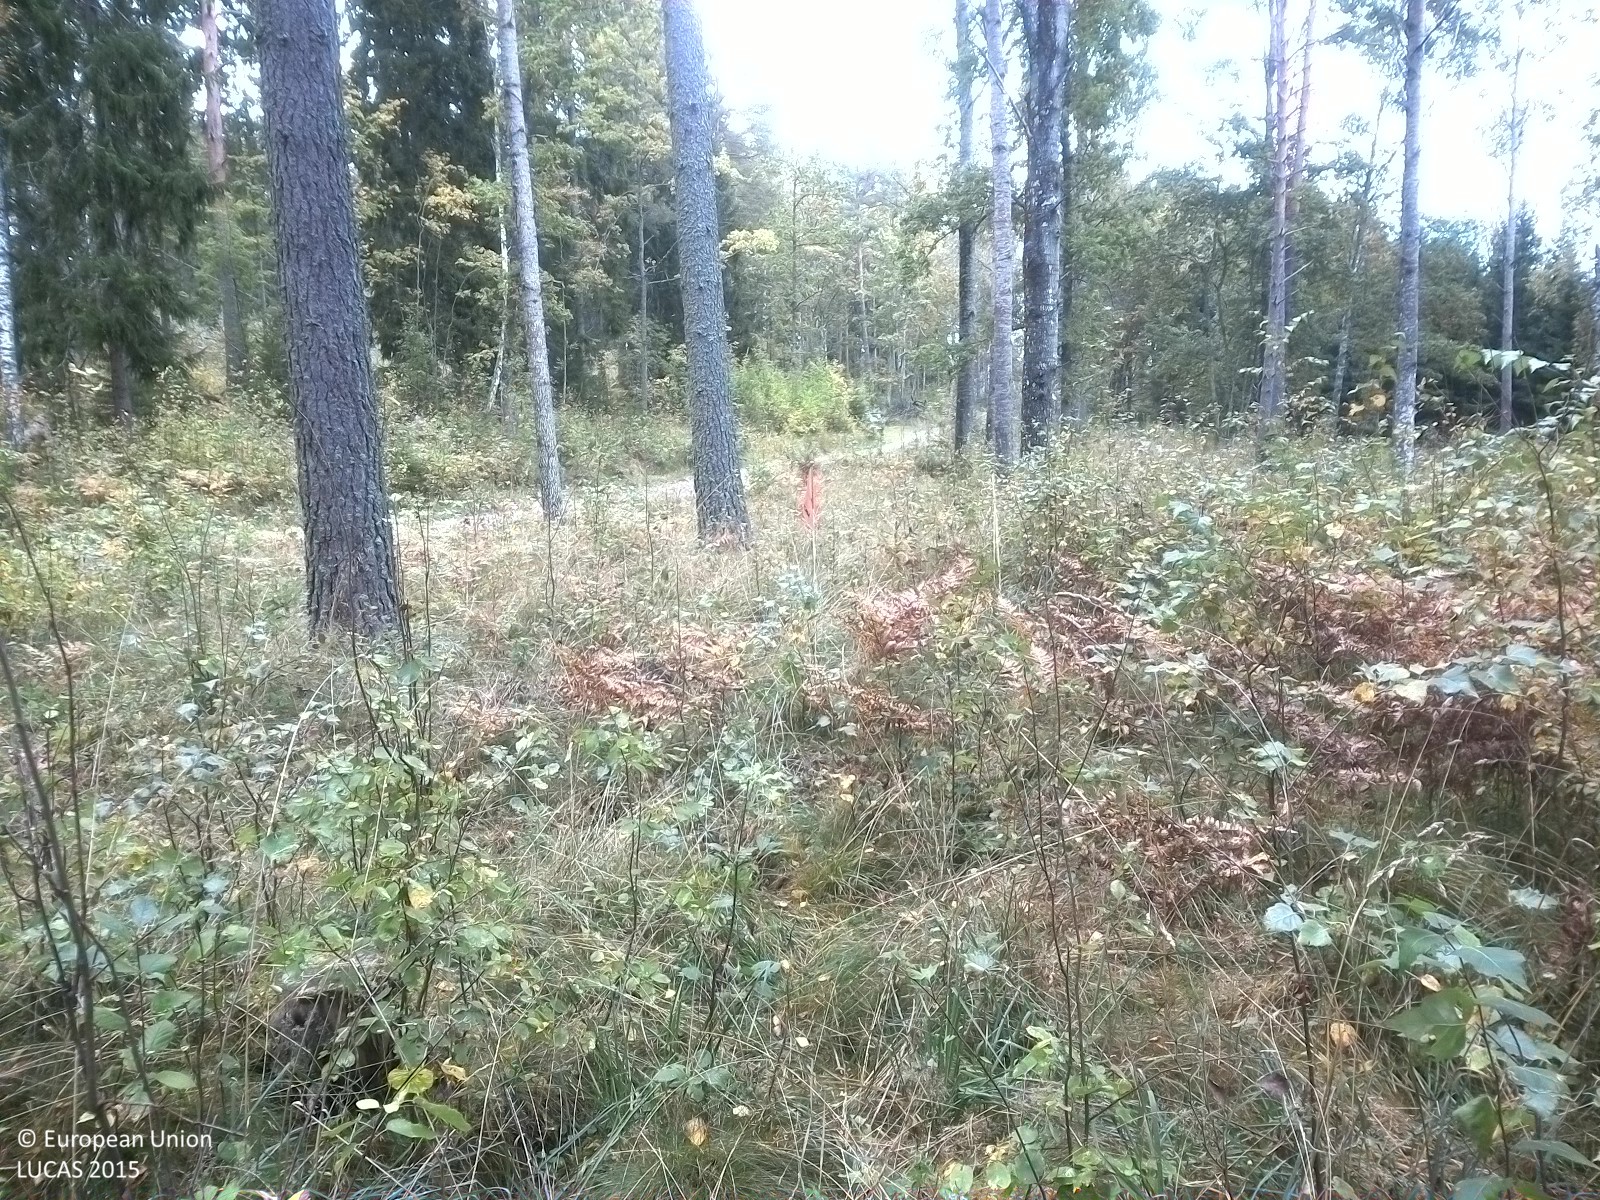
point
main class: Woodland
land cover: Pine dominated mixed woodland
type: boreal forest
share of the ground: 25 - 50 %
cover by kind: herbaceous plants 45 %, coniferous forest trees 25 %, broadleaved forest trees 15 %, shrubs 10 %, lichens and mosses 5 %
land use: Forestry
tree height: > 5 m
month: September
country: SE
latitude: 58.9223
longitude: 15.8465
